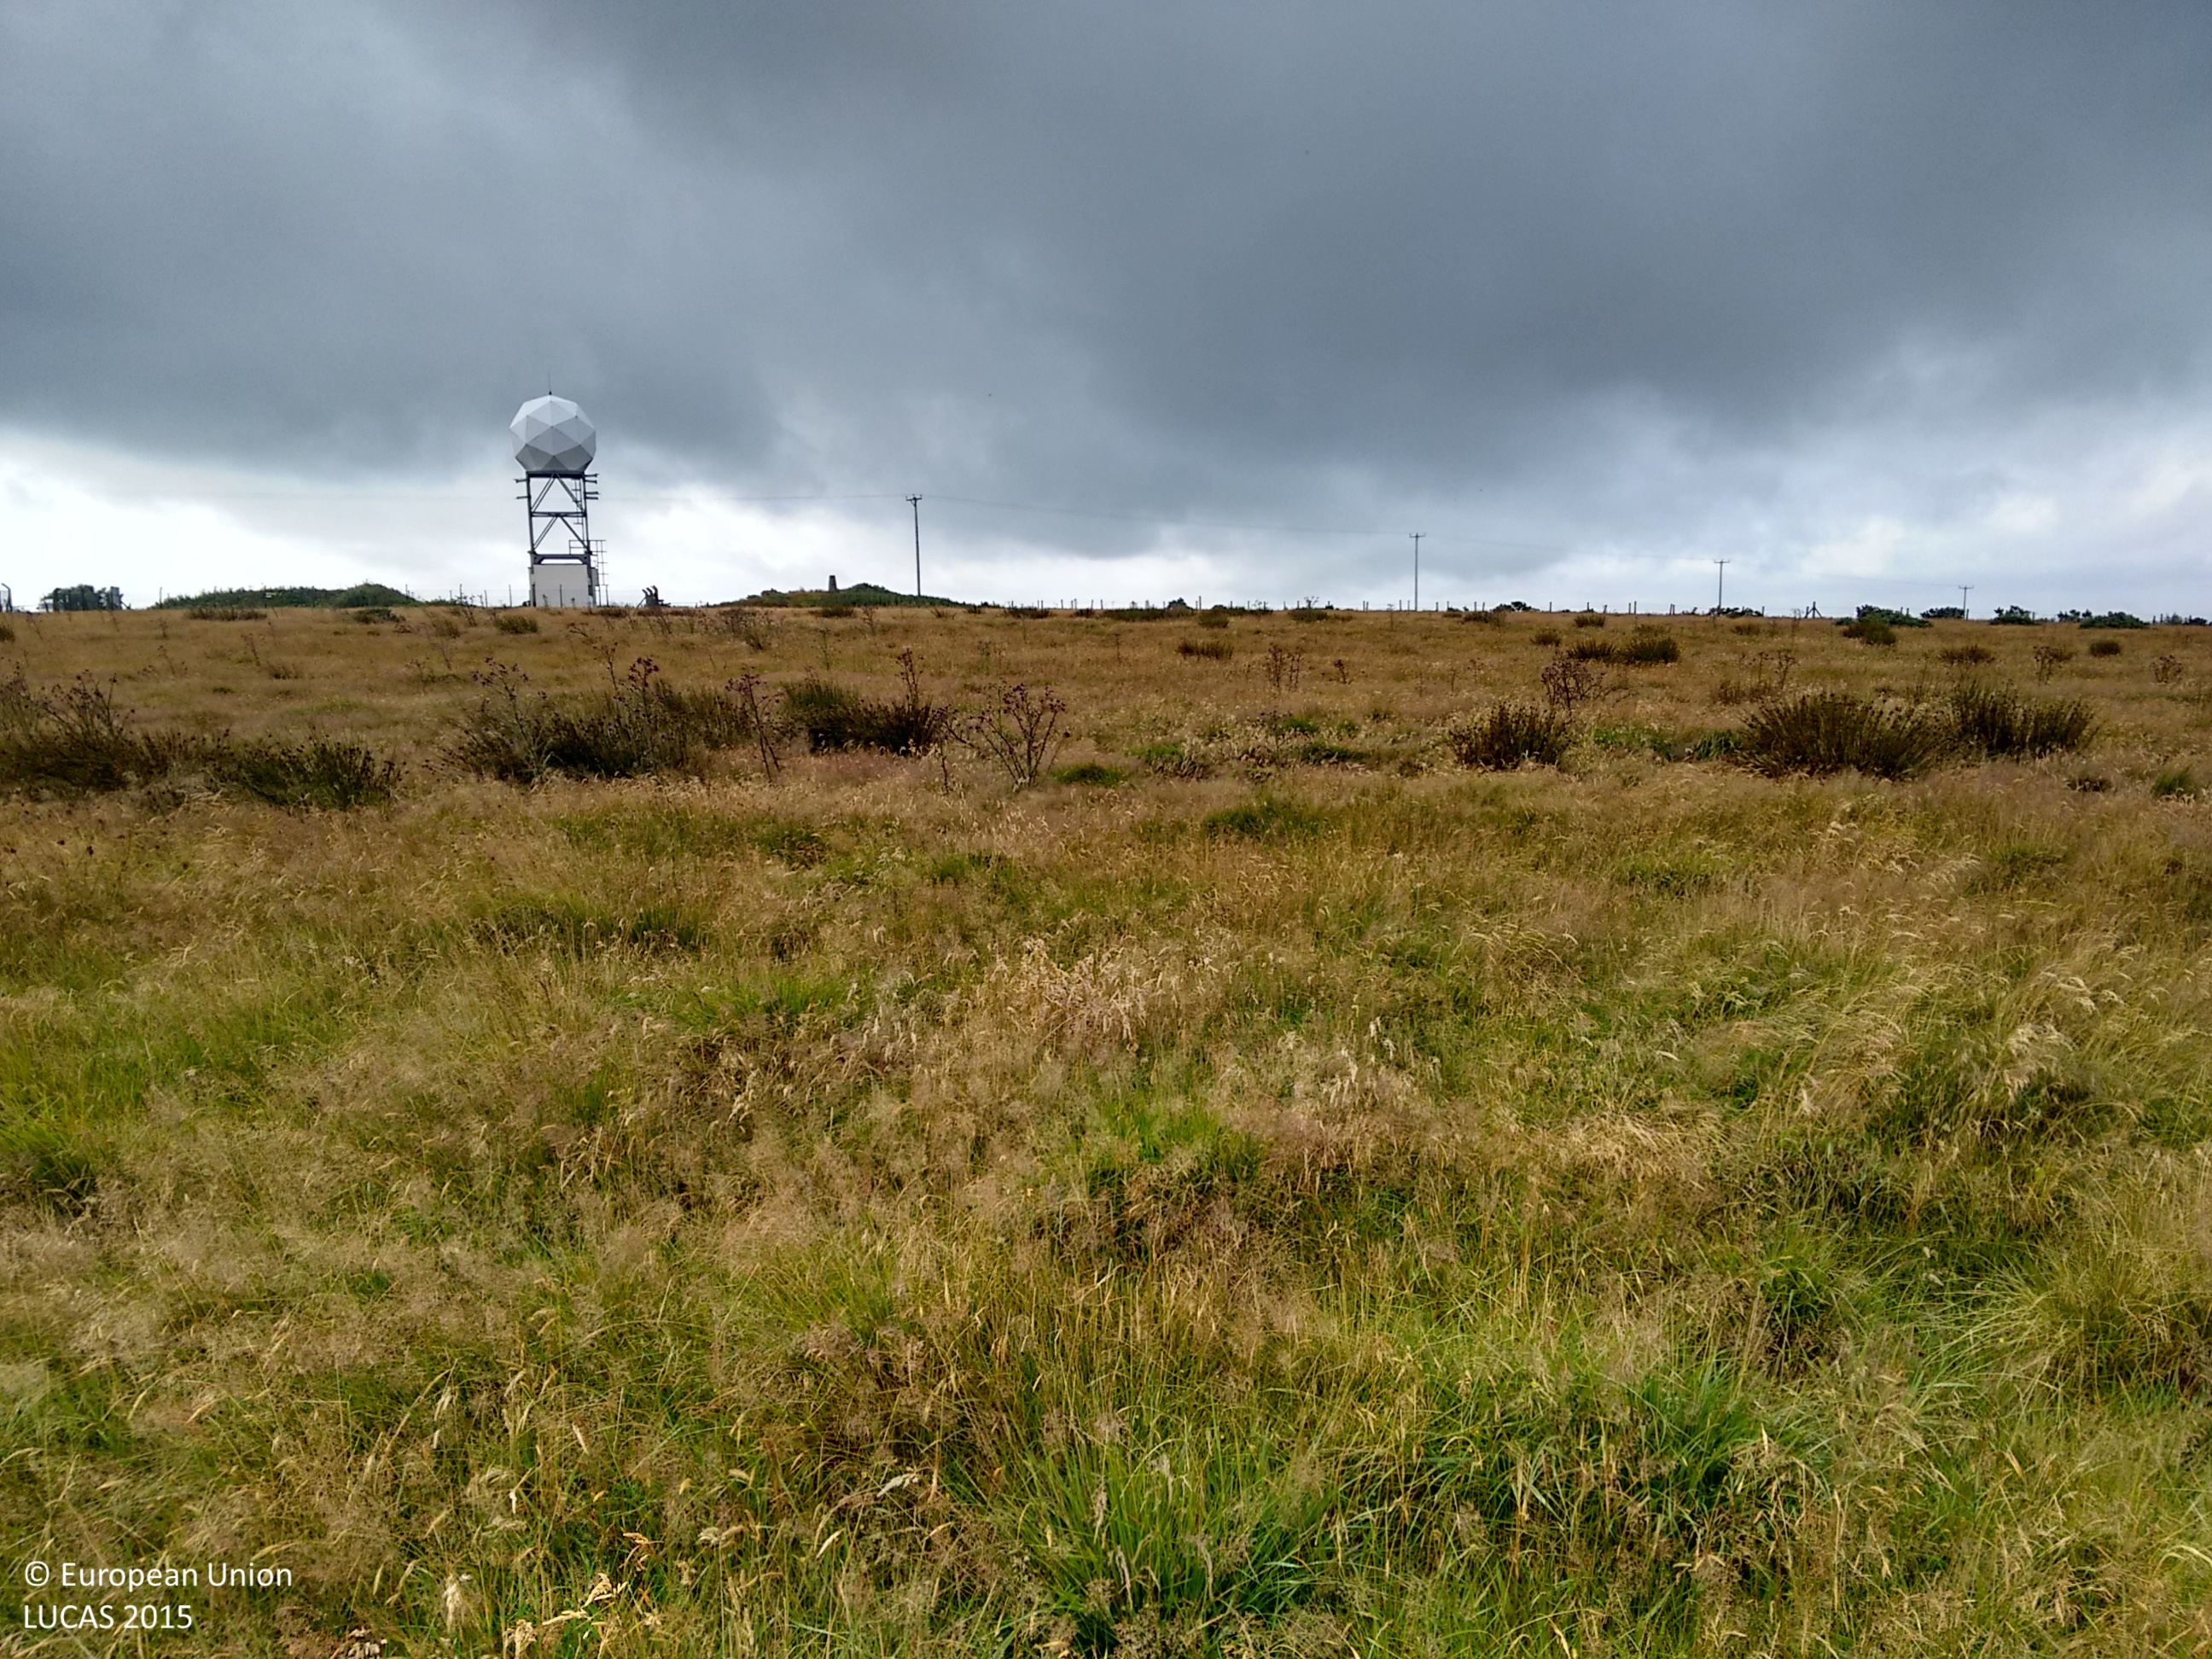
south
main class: Grassland
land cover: Grassland without tree/shrub cover
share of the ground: > 75 %
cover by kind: herbaceous plants 100 %
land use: Agriculture (excluding fallow land and kitchen gardens)
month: August
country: GB
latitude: 51.9810
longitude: -4.4455
